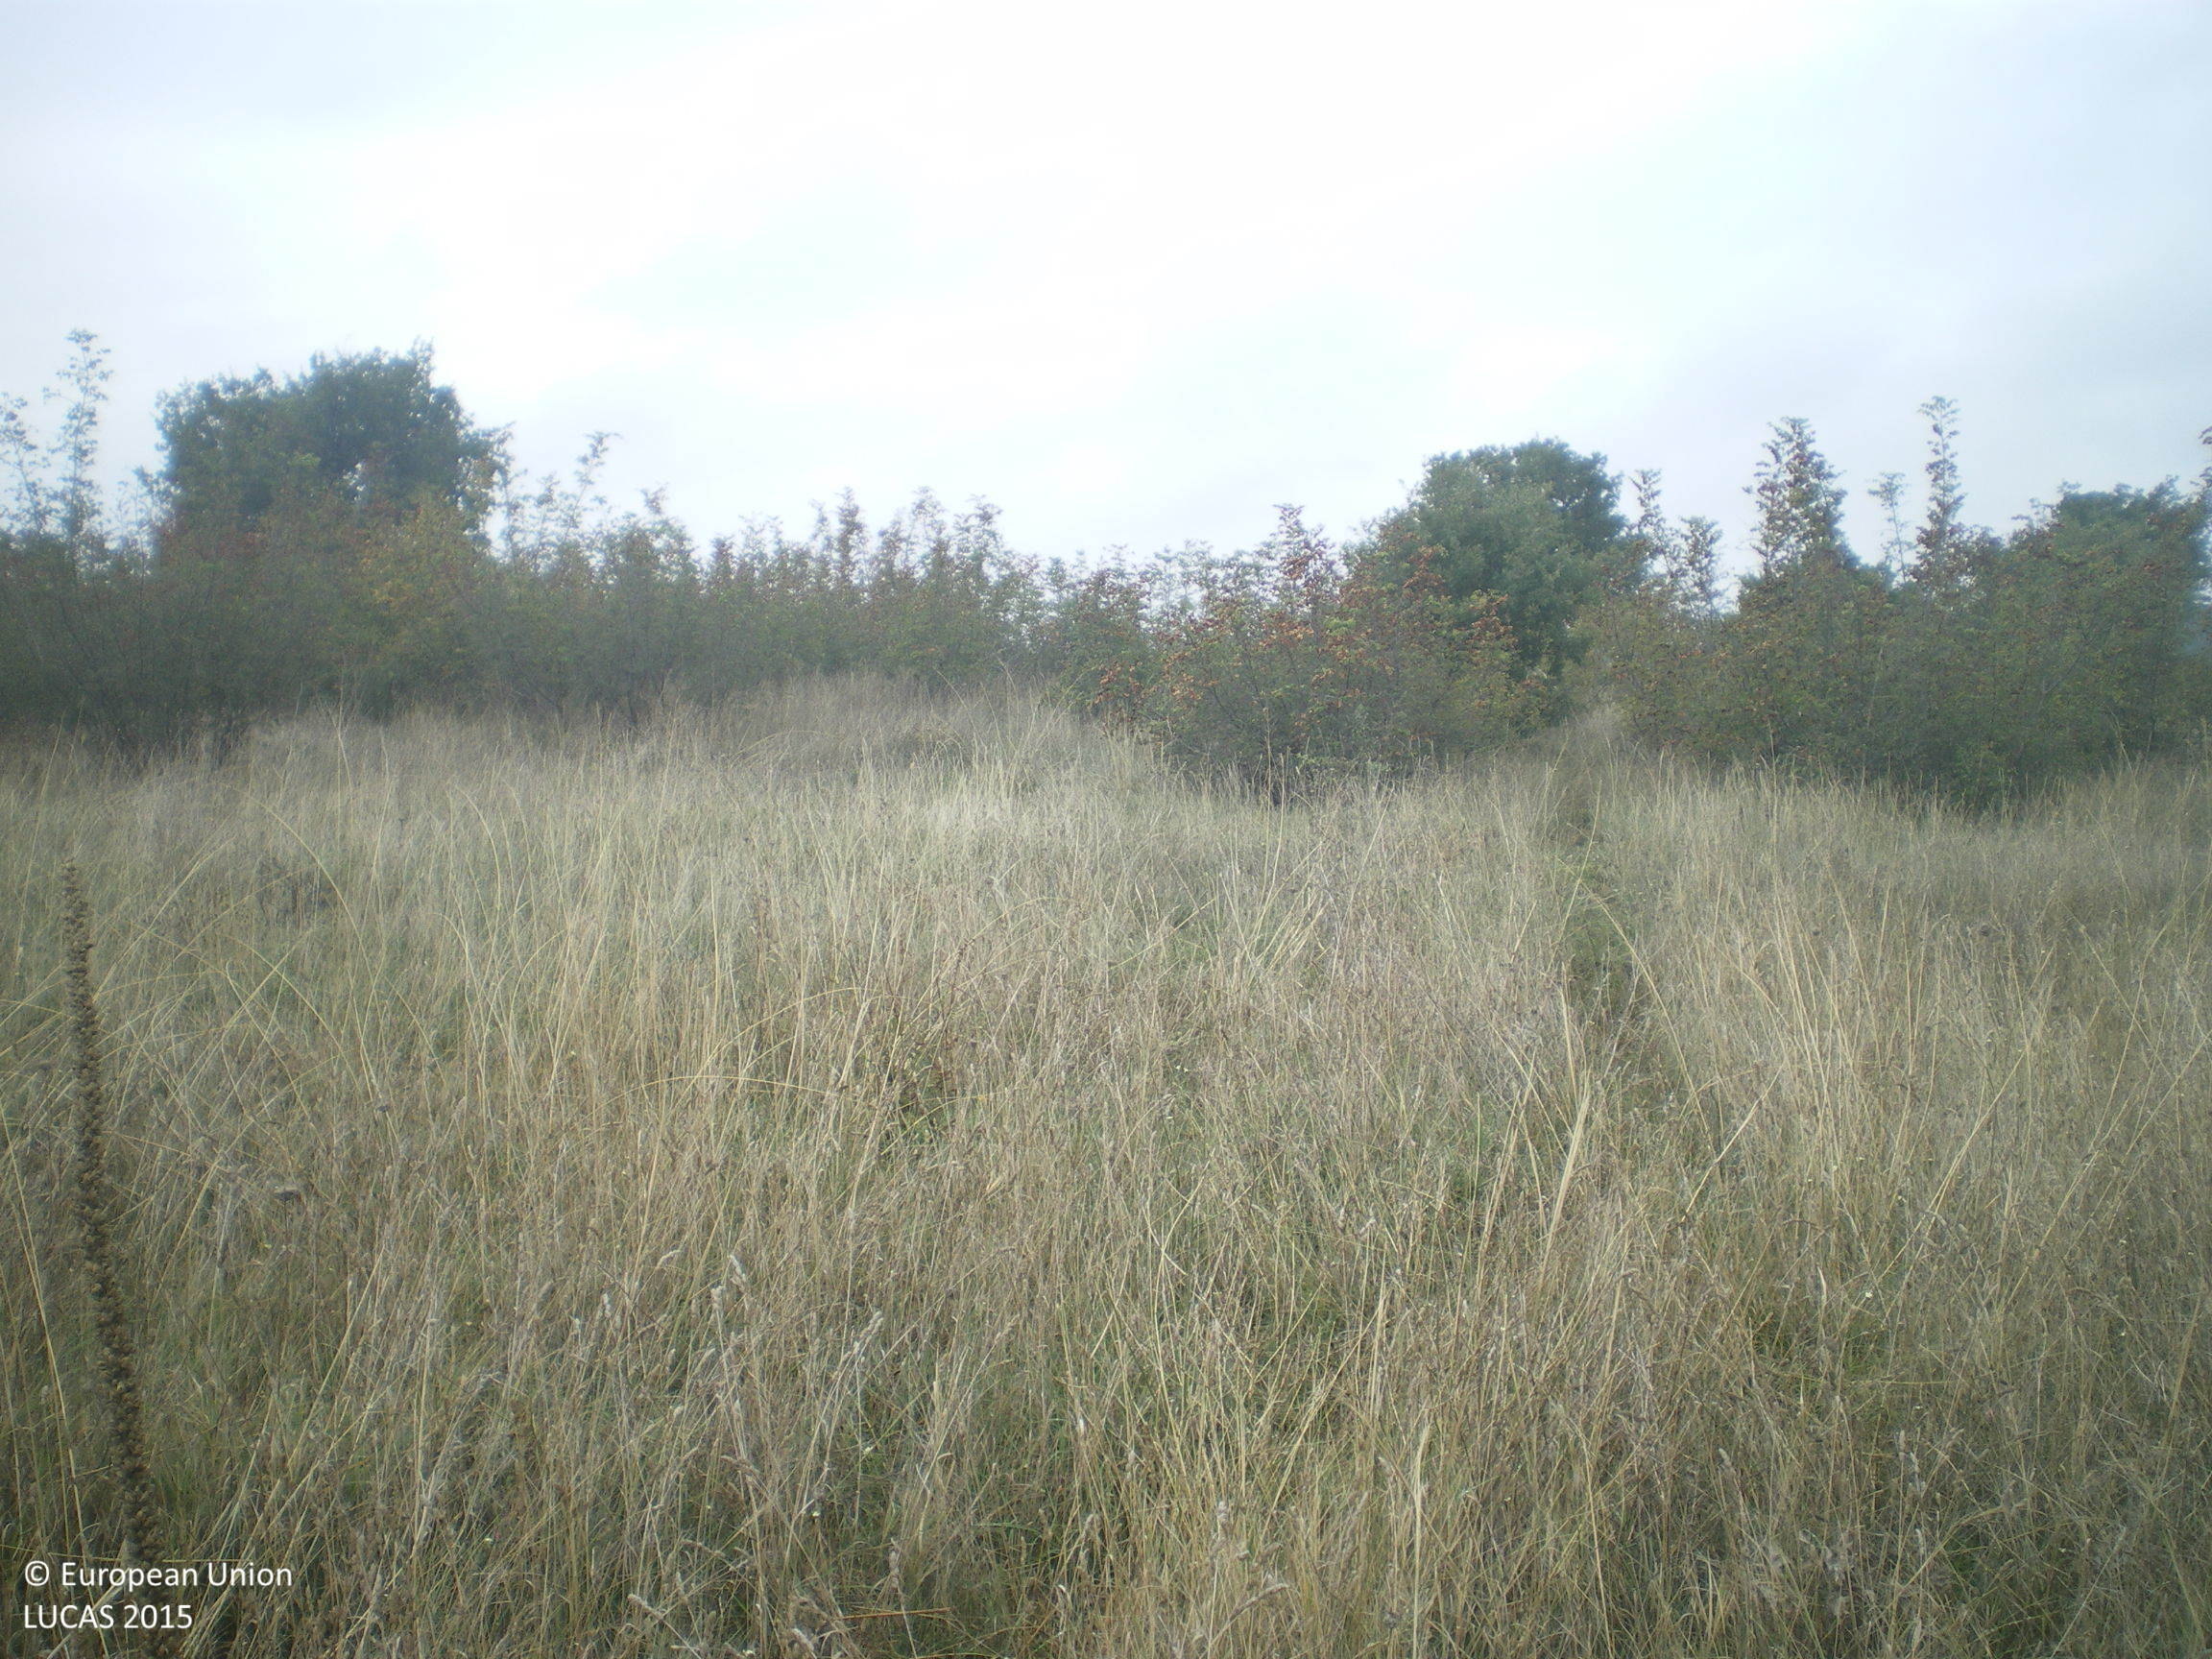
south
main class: Grassland
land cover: Grassland with sparse tree/shrub cover
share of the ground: > 75 %
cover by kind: herbaceous plants 90 %, broadleaved forest trees 5 %, shrubs 5 %
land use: Agriculture (excluding fallow land and kitchen gardens)
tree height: > 5 m
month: October
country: BG
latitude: 41.8751
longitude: 26.1867
